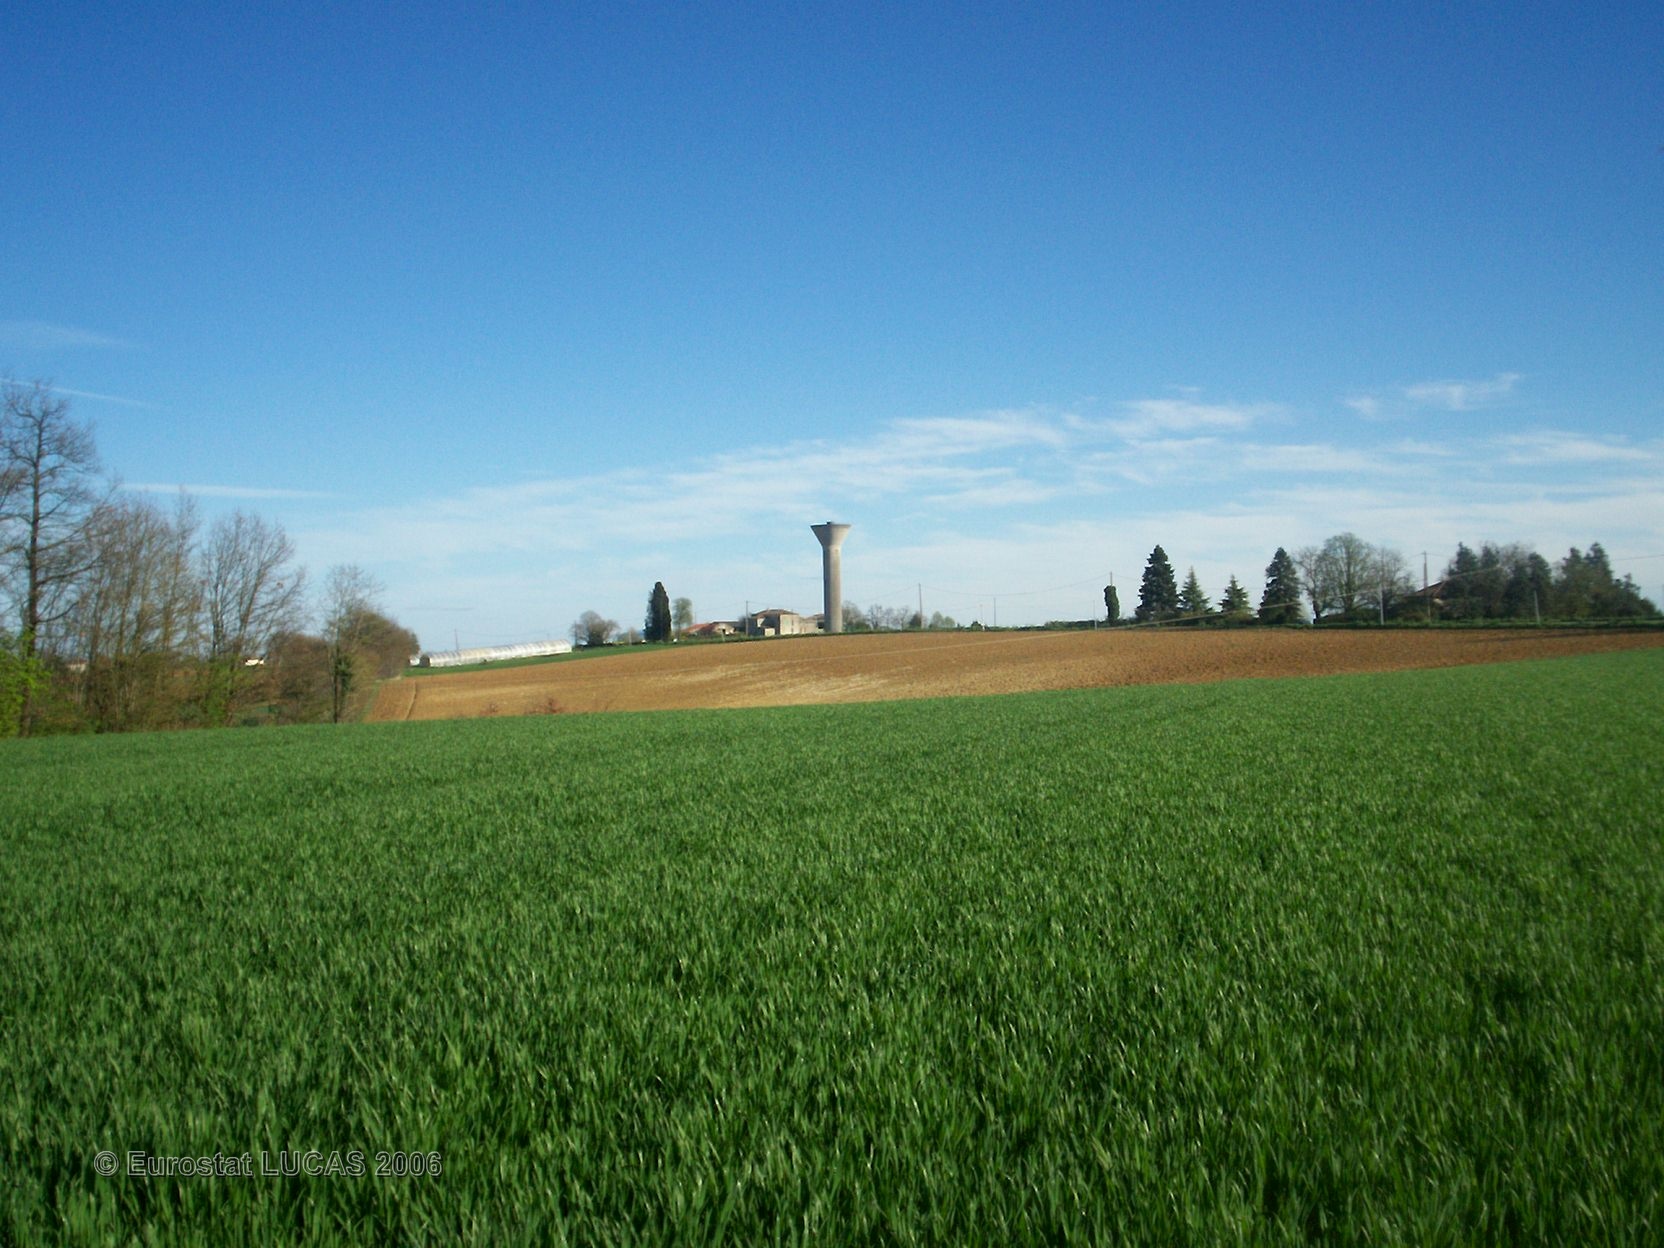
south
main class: Cropland
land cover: Common wheat
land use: Agriculture (excluding fallow land and kitchen gardens)
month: April
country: FR
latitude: 44.2619
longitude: 0.9400
